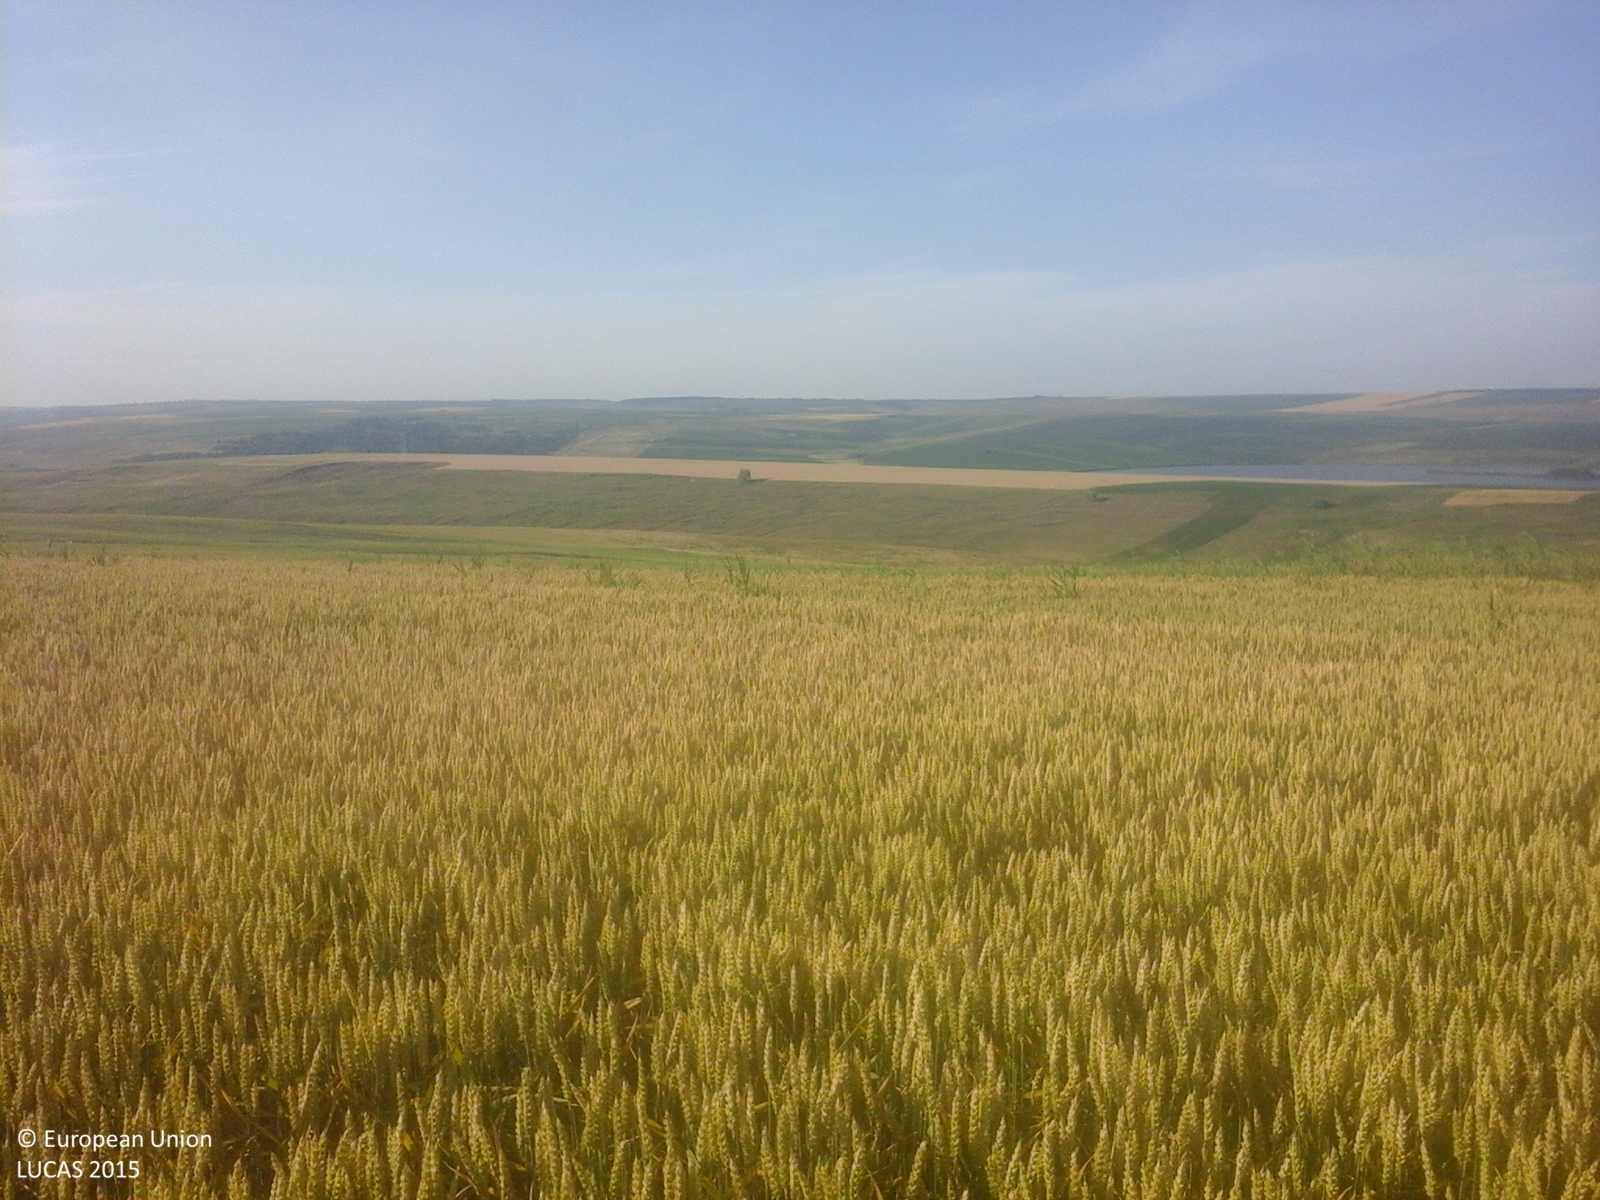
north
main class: Cropland
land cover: Common wheat
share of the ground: > 75 %
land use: Agriculture (excluding fallow land and kitchen gardens)
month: June
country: RO
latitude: 47.9094
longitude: 26.9488
